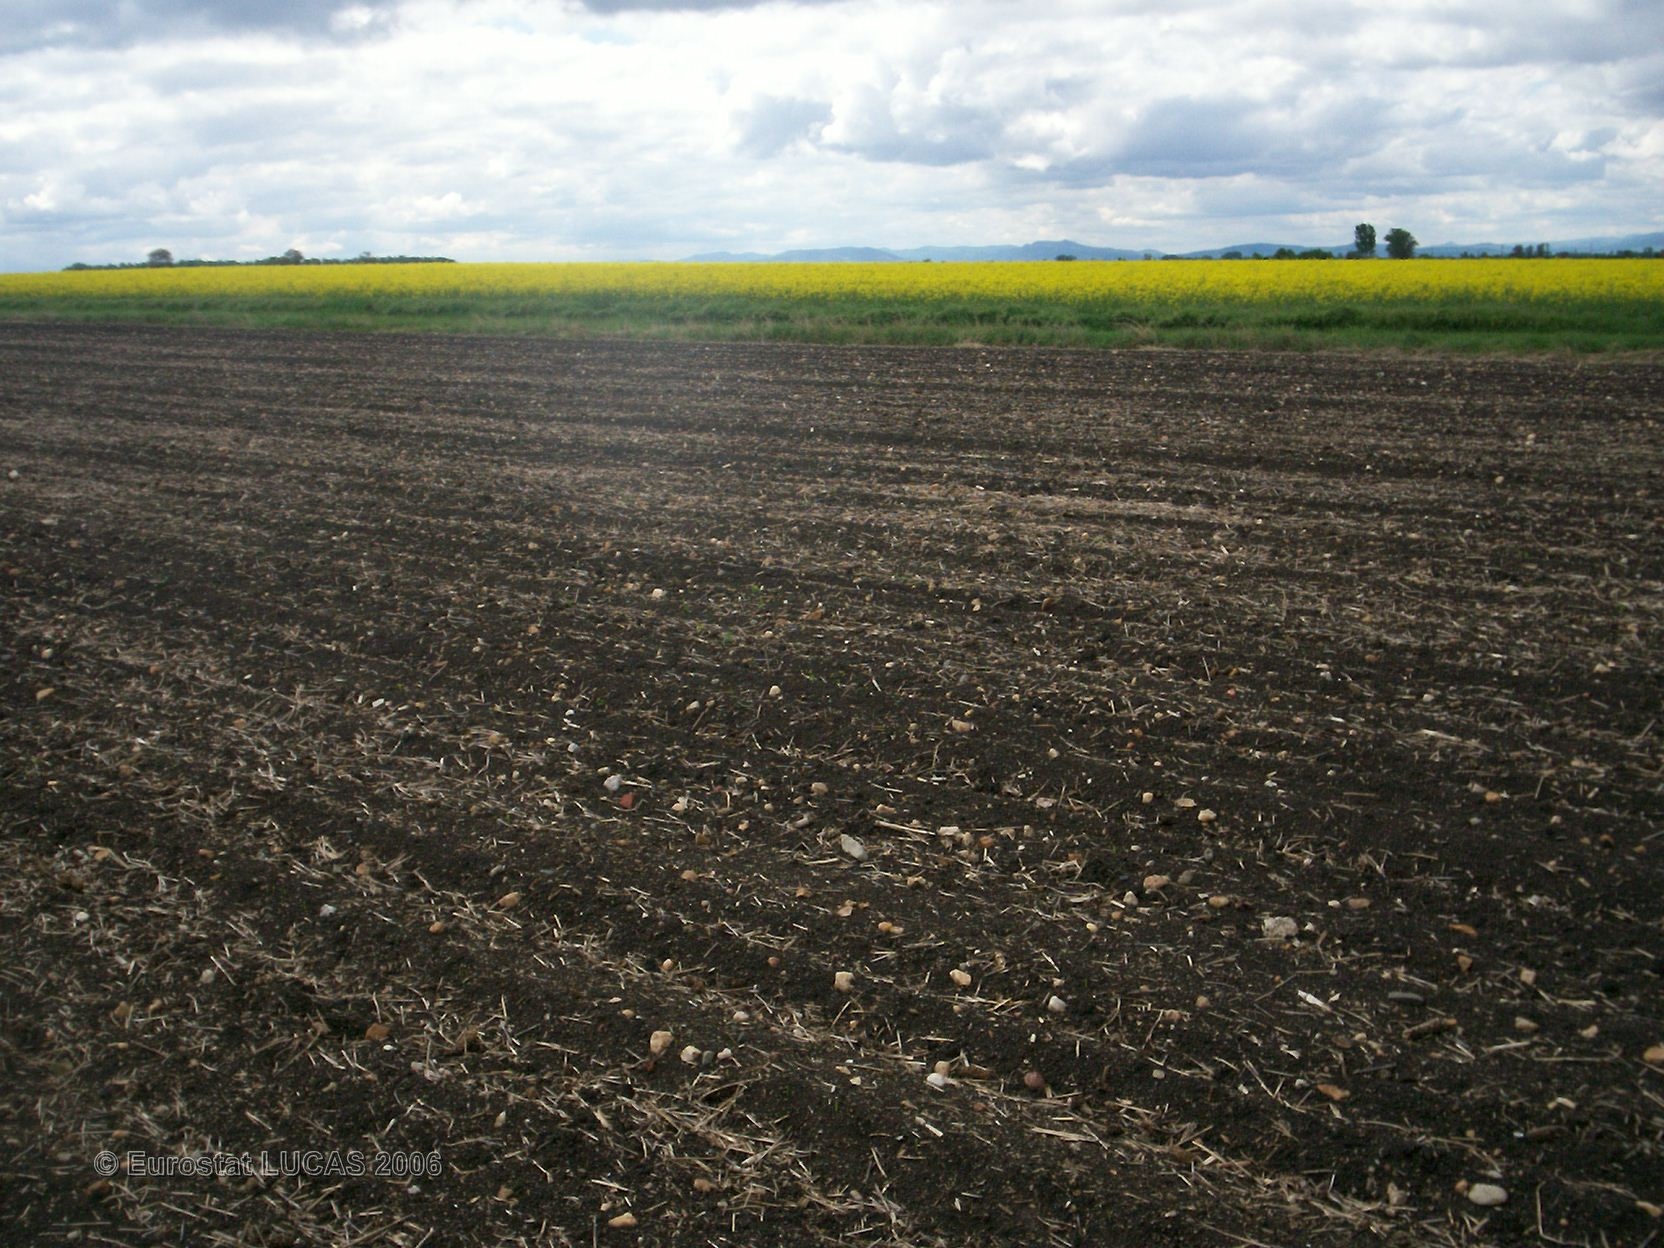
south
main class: Cropland
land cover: Maize
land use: Agriculture (excluding fallow land and kitchen gardens)
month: May
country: FR
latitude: 45.9344
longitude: 3.1769
